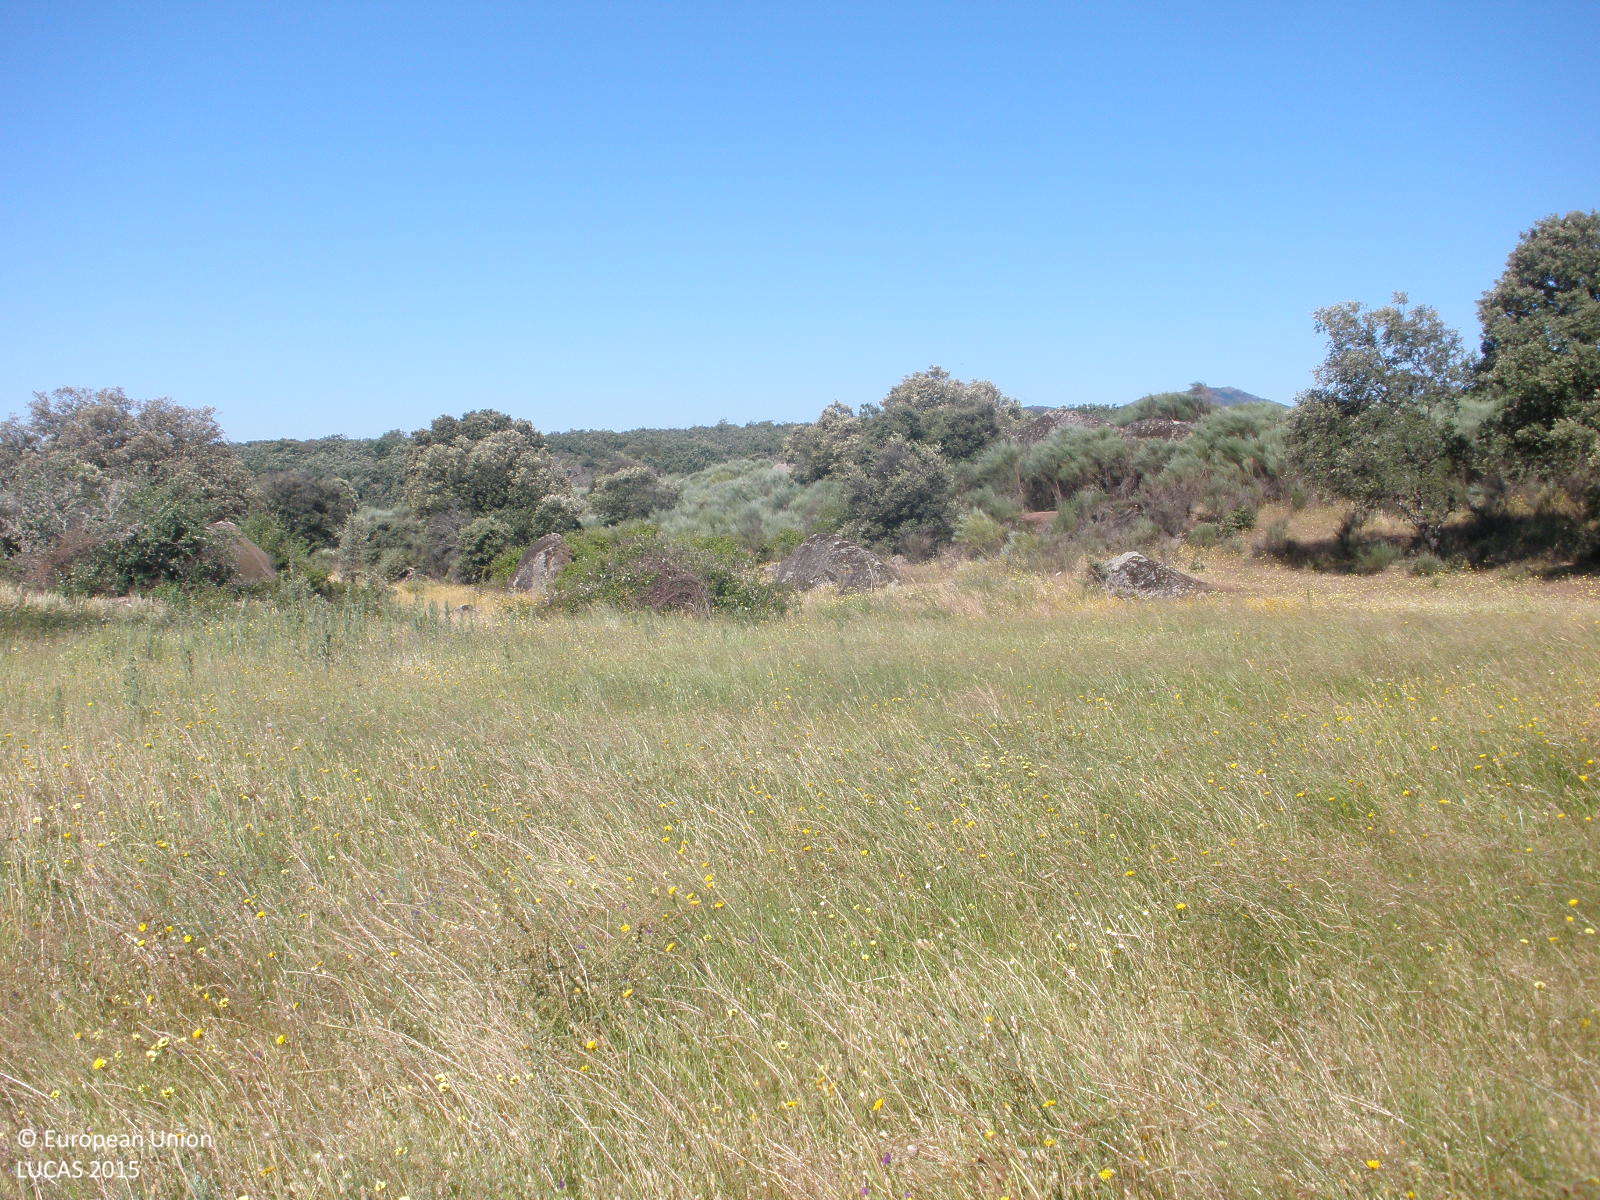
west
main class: Grassland
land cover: Grassland without tree/shrub cover
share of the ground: > 75 %
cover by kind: herbaceous plants 100 %
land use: Agriculture (excluding fallow land and kitchen gardens)
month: May
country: ES
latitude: 40.1692
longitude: -6.2700
